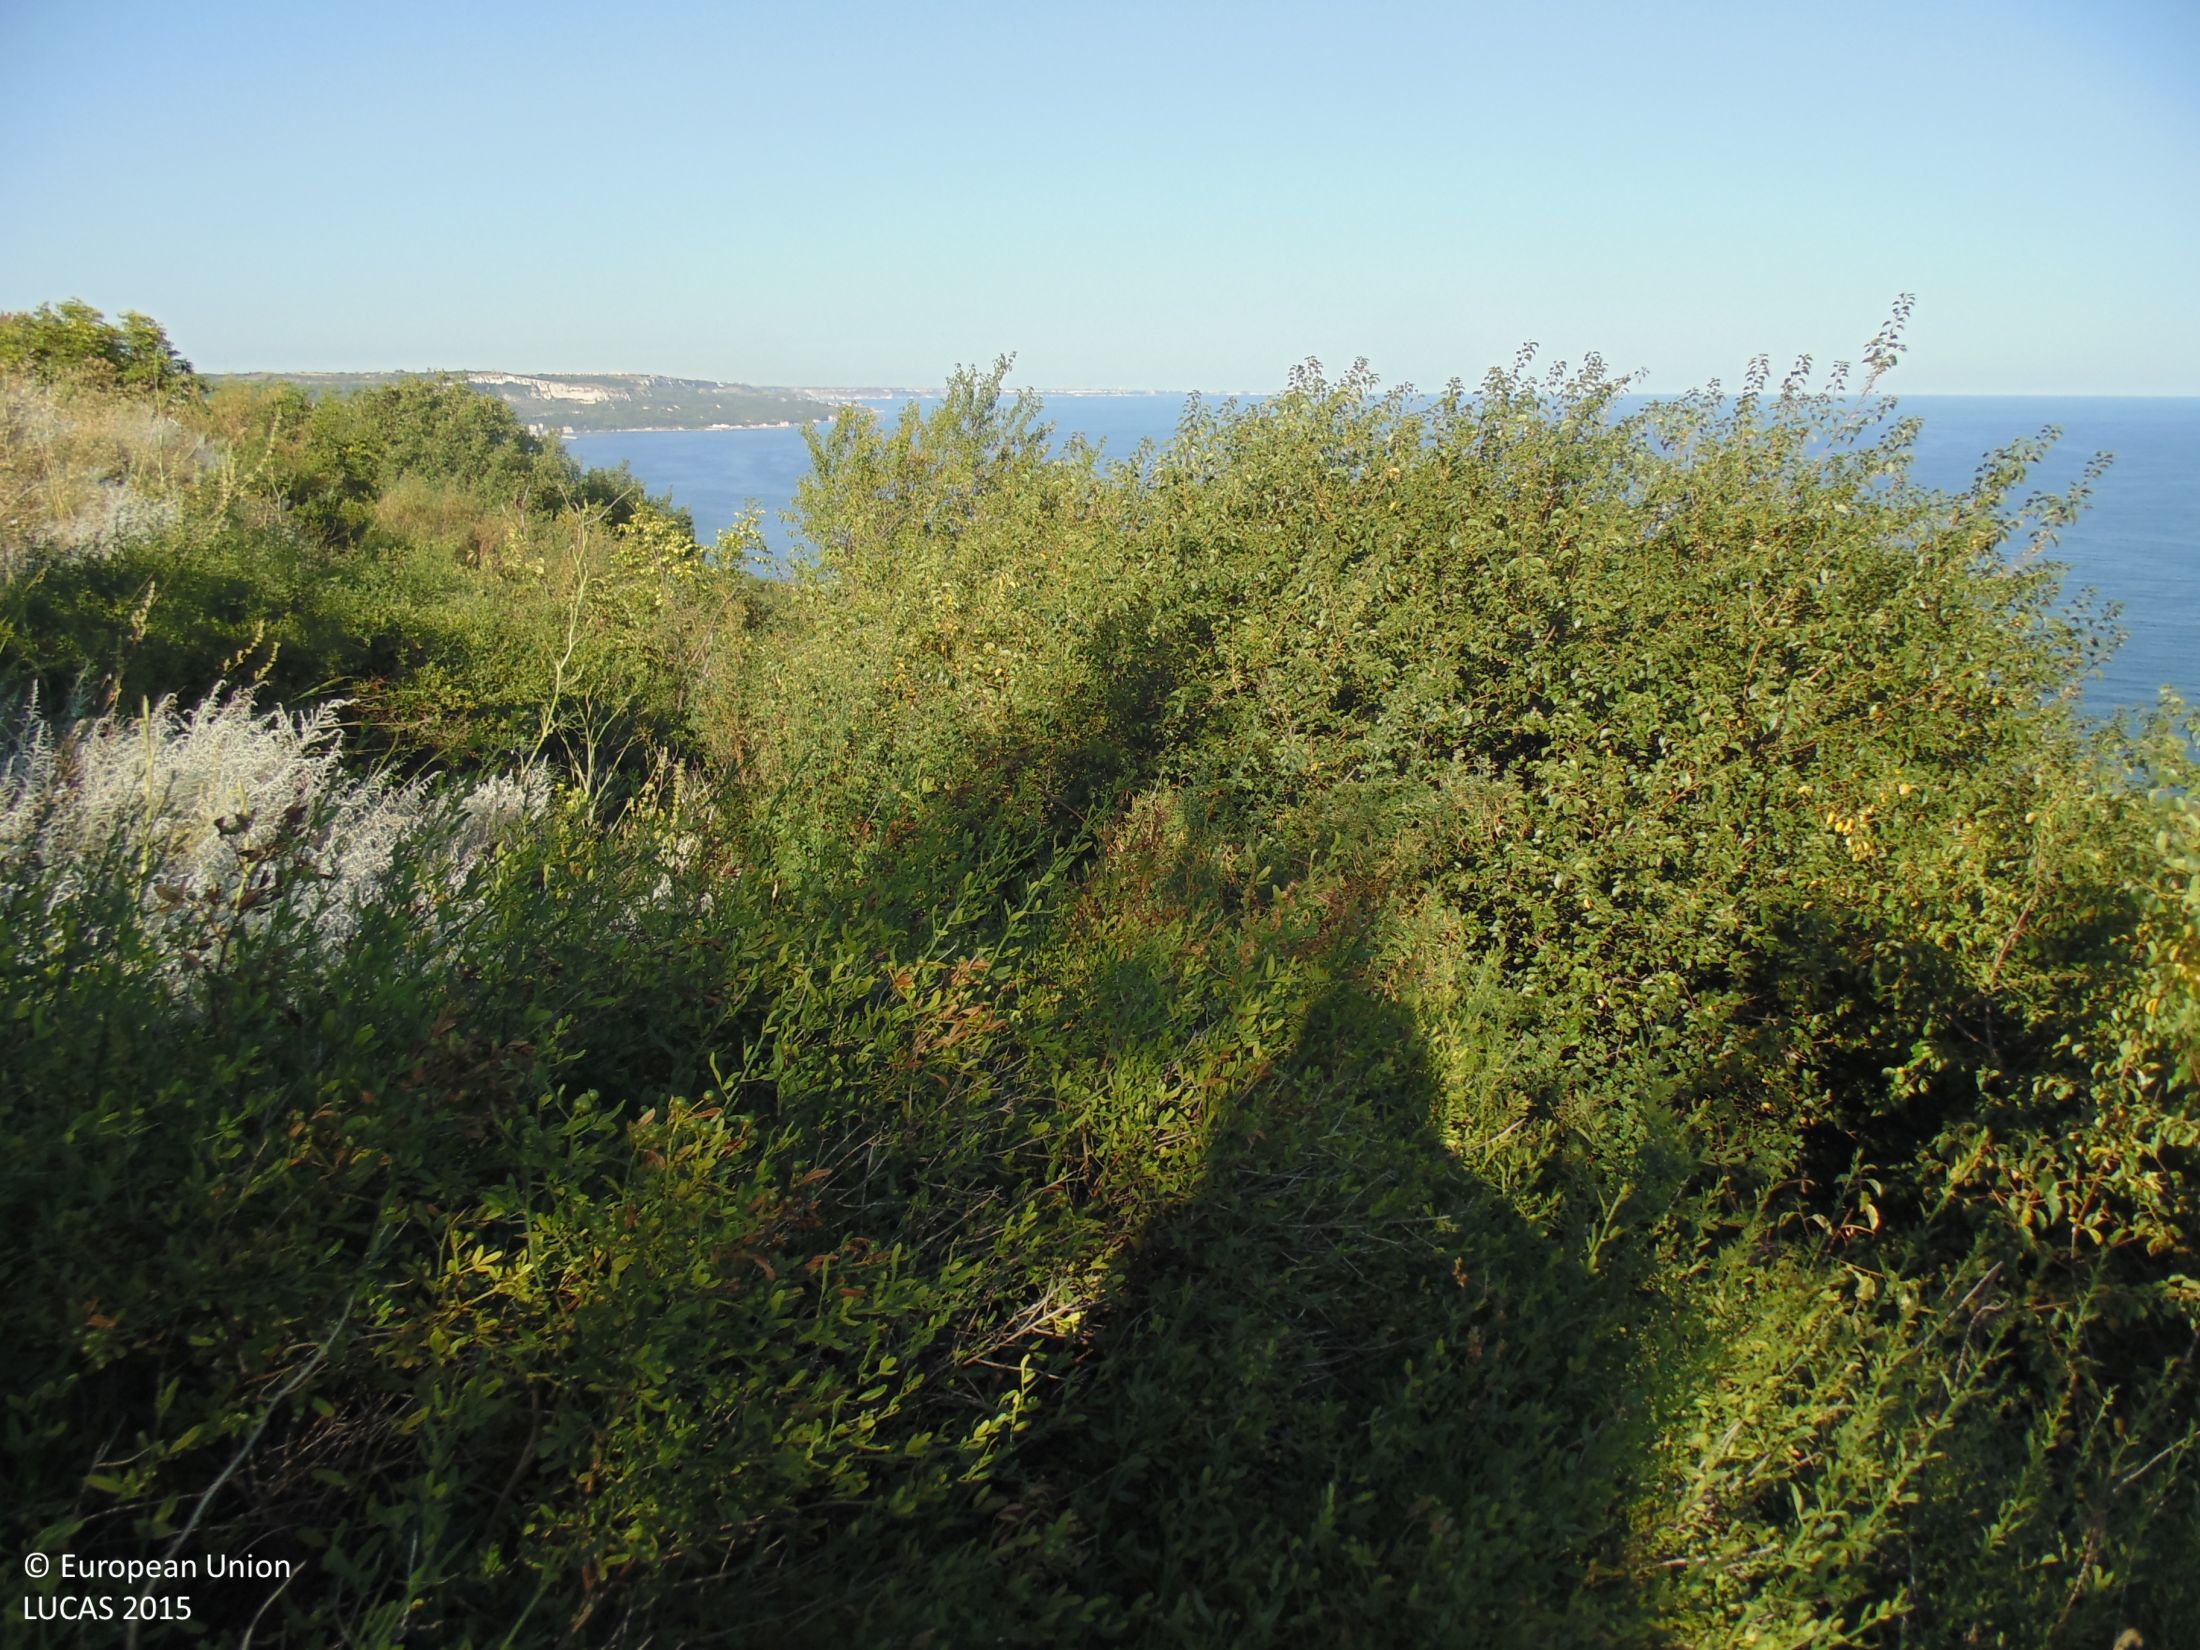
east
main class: Shrubland
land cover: Shrubland without tree cover
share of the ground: > 75 %
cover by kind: herbaceous plants 70 %, shrubs 30 %
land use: Semi-natural and natural areas not in use
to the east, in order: Shrubland without tree cover; Grassland with sparse tree/shrub cover; Broadleaved woodland
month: July
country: BG
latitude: 43.3867
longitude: 28.1085
